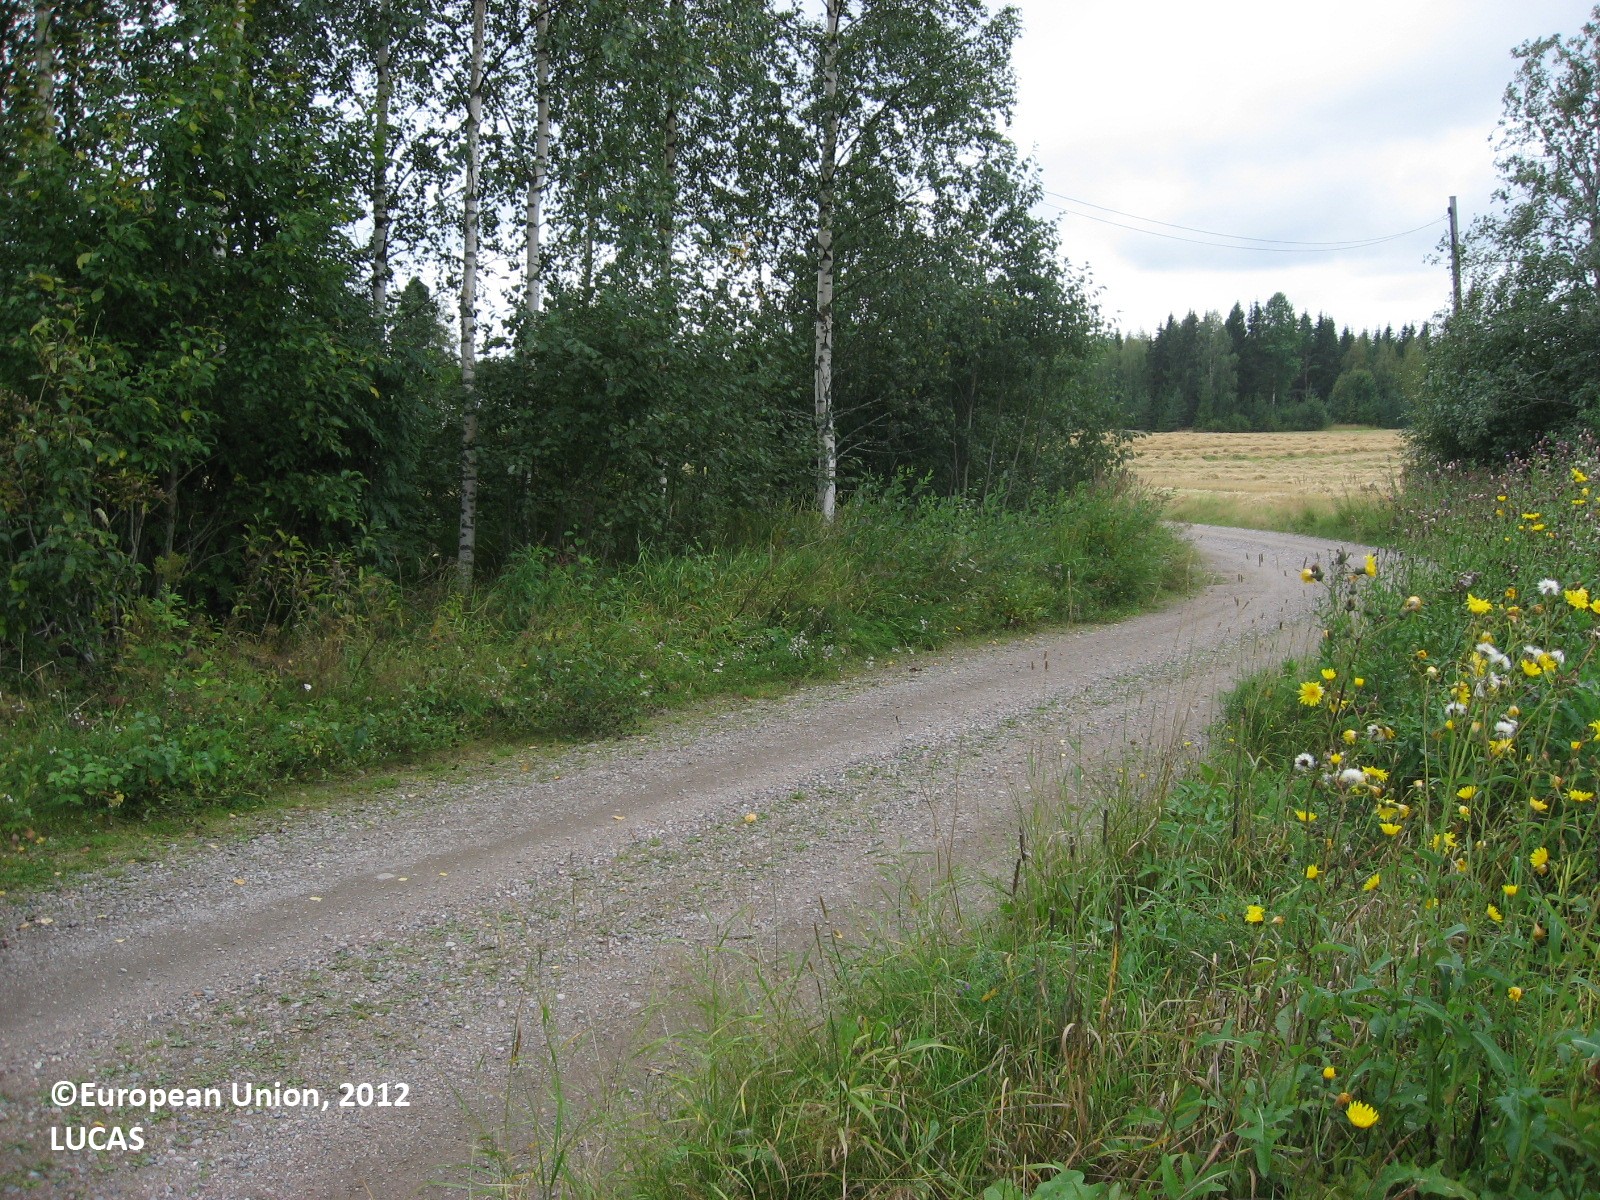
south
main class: Cropland
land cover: Rape and turnip rape
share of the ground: 50 - 75 %
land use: Agriculture (excluding fallow land and kitchen gardens)
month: August
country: FI
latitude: 60.9343
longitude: 25.3457
